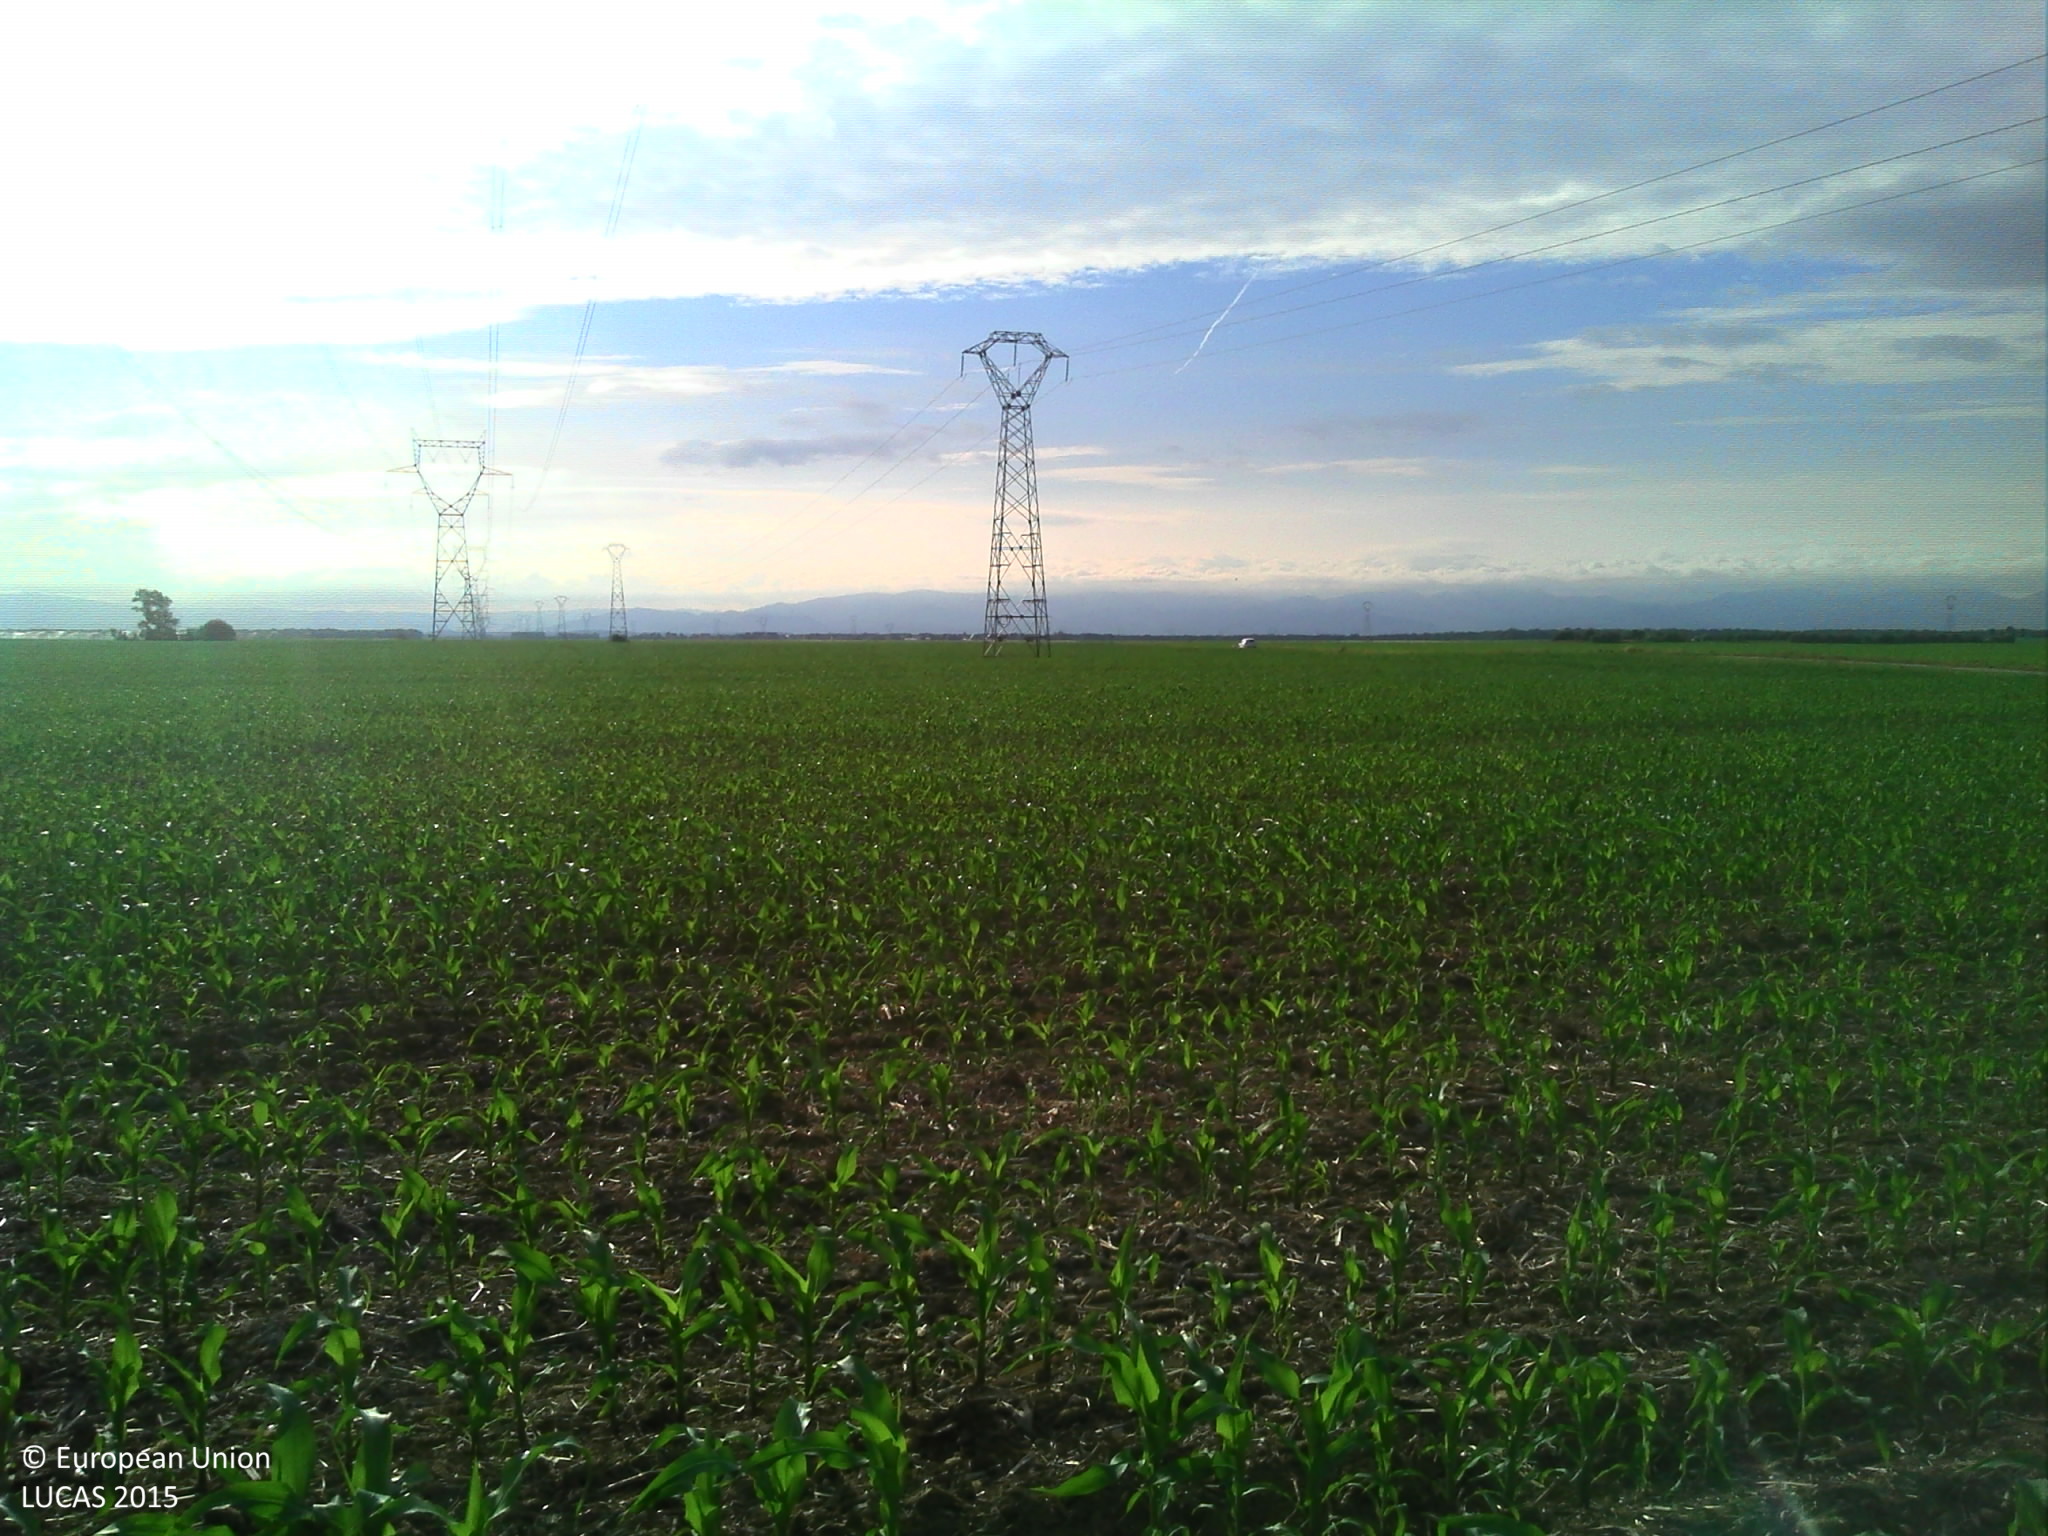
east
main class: Cropland
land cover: Maize
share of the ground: 10 - 25 %
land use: Agriculture (excluding fallow land and kitchen gardens)
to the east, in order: Maize; Electric lines; Maize; Grass margins; Paved roads, cycling and walking lanes; Grass margins; Maize
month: June
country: FR
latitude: 48.0132
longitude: 7.4139
